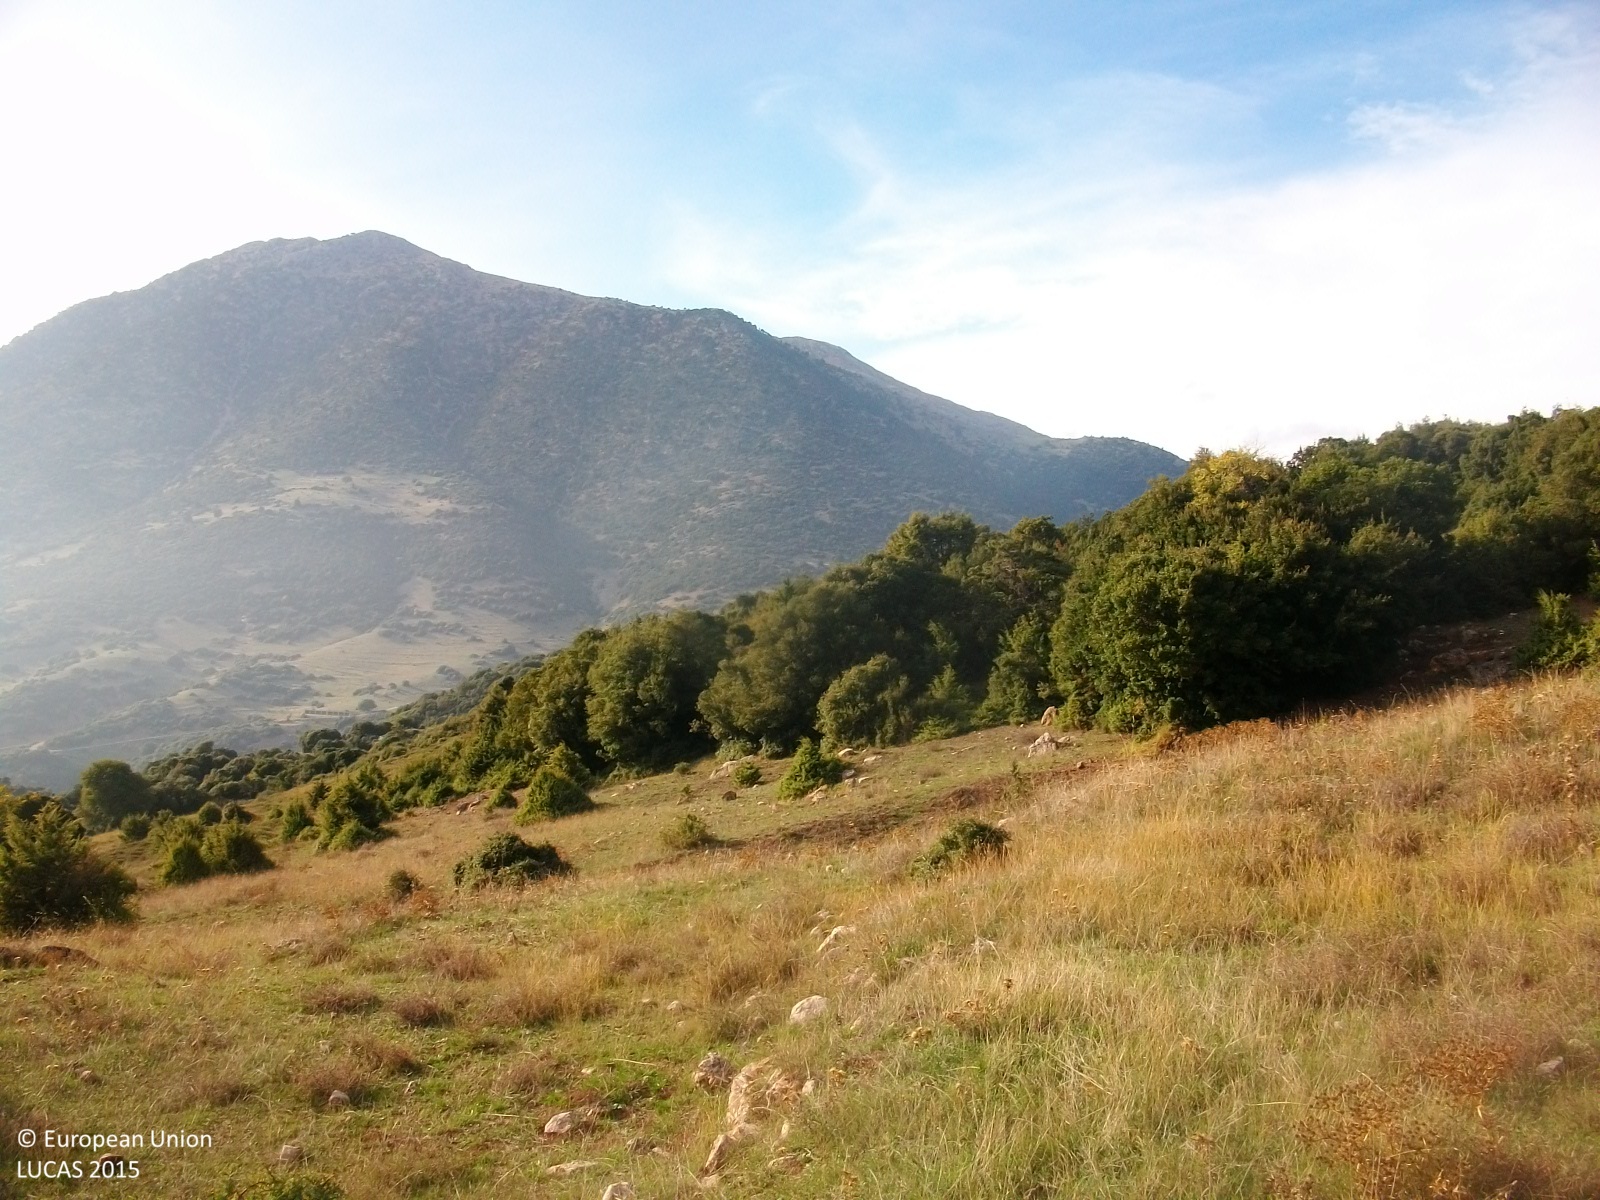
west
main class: Grassland
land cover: Grassland with sparse tree/shrub cover
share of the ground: > 75 %
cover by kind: herbaceous plants 80 %, unconsolidated bare surface 10 %, coniferous forest trees 5 %, shrubs 5 %
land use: Semi-natural and natural areas not in use
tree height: < 5 m
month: October
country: GR
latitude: 37.8860
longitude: 22.3950
